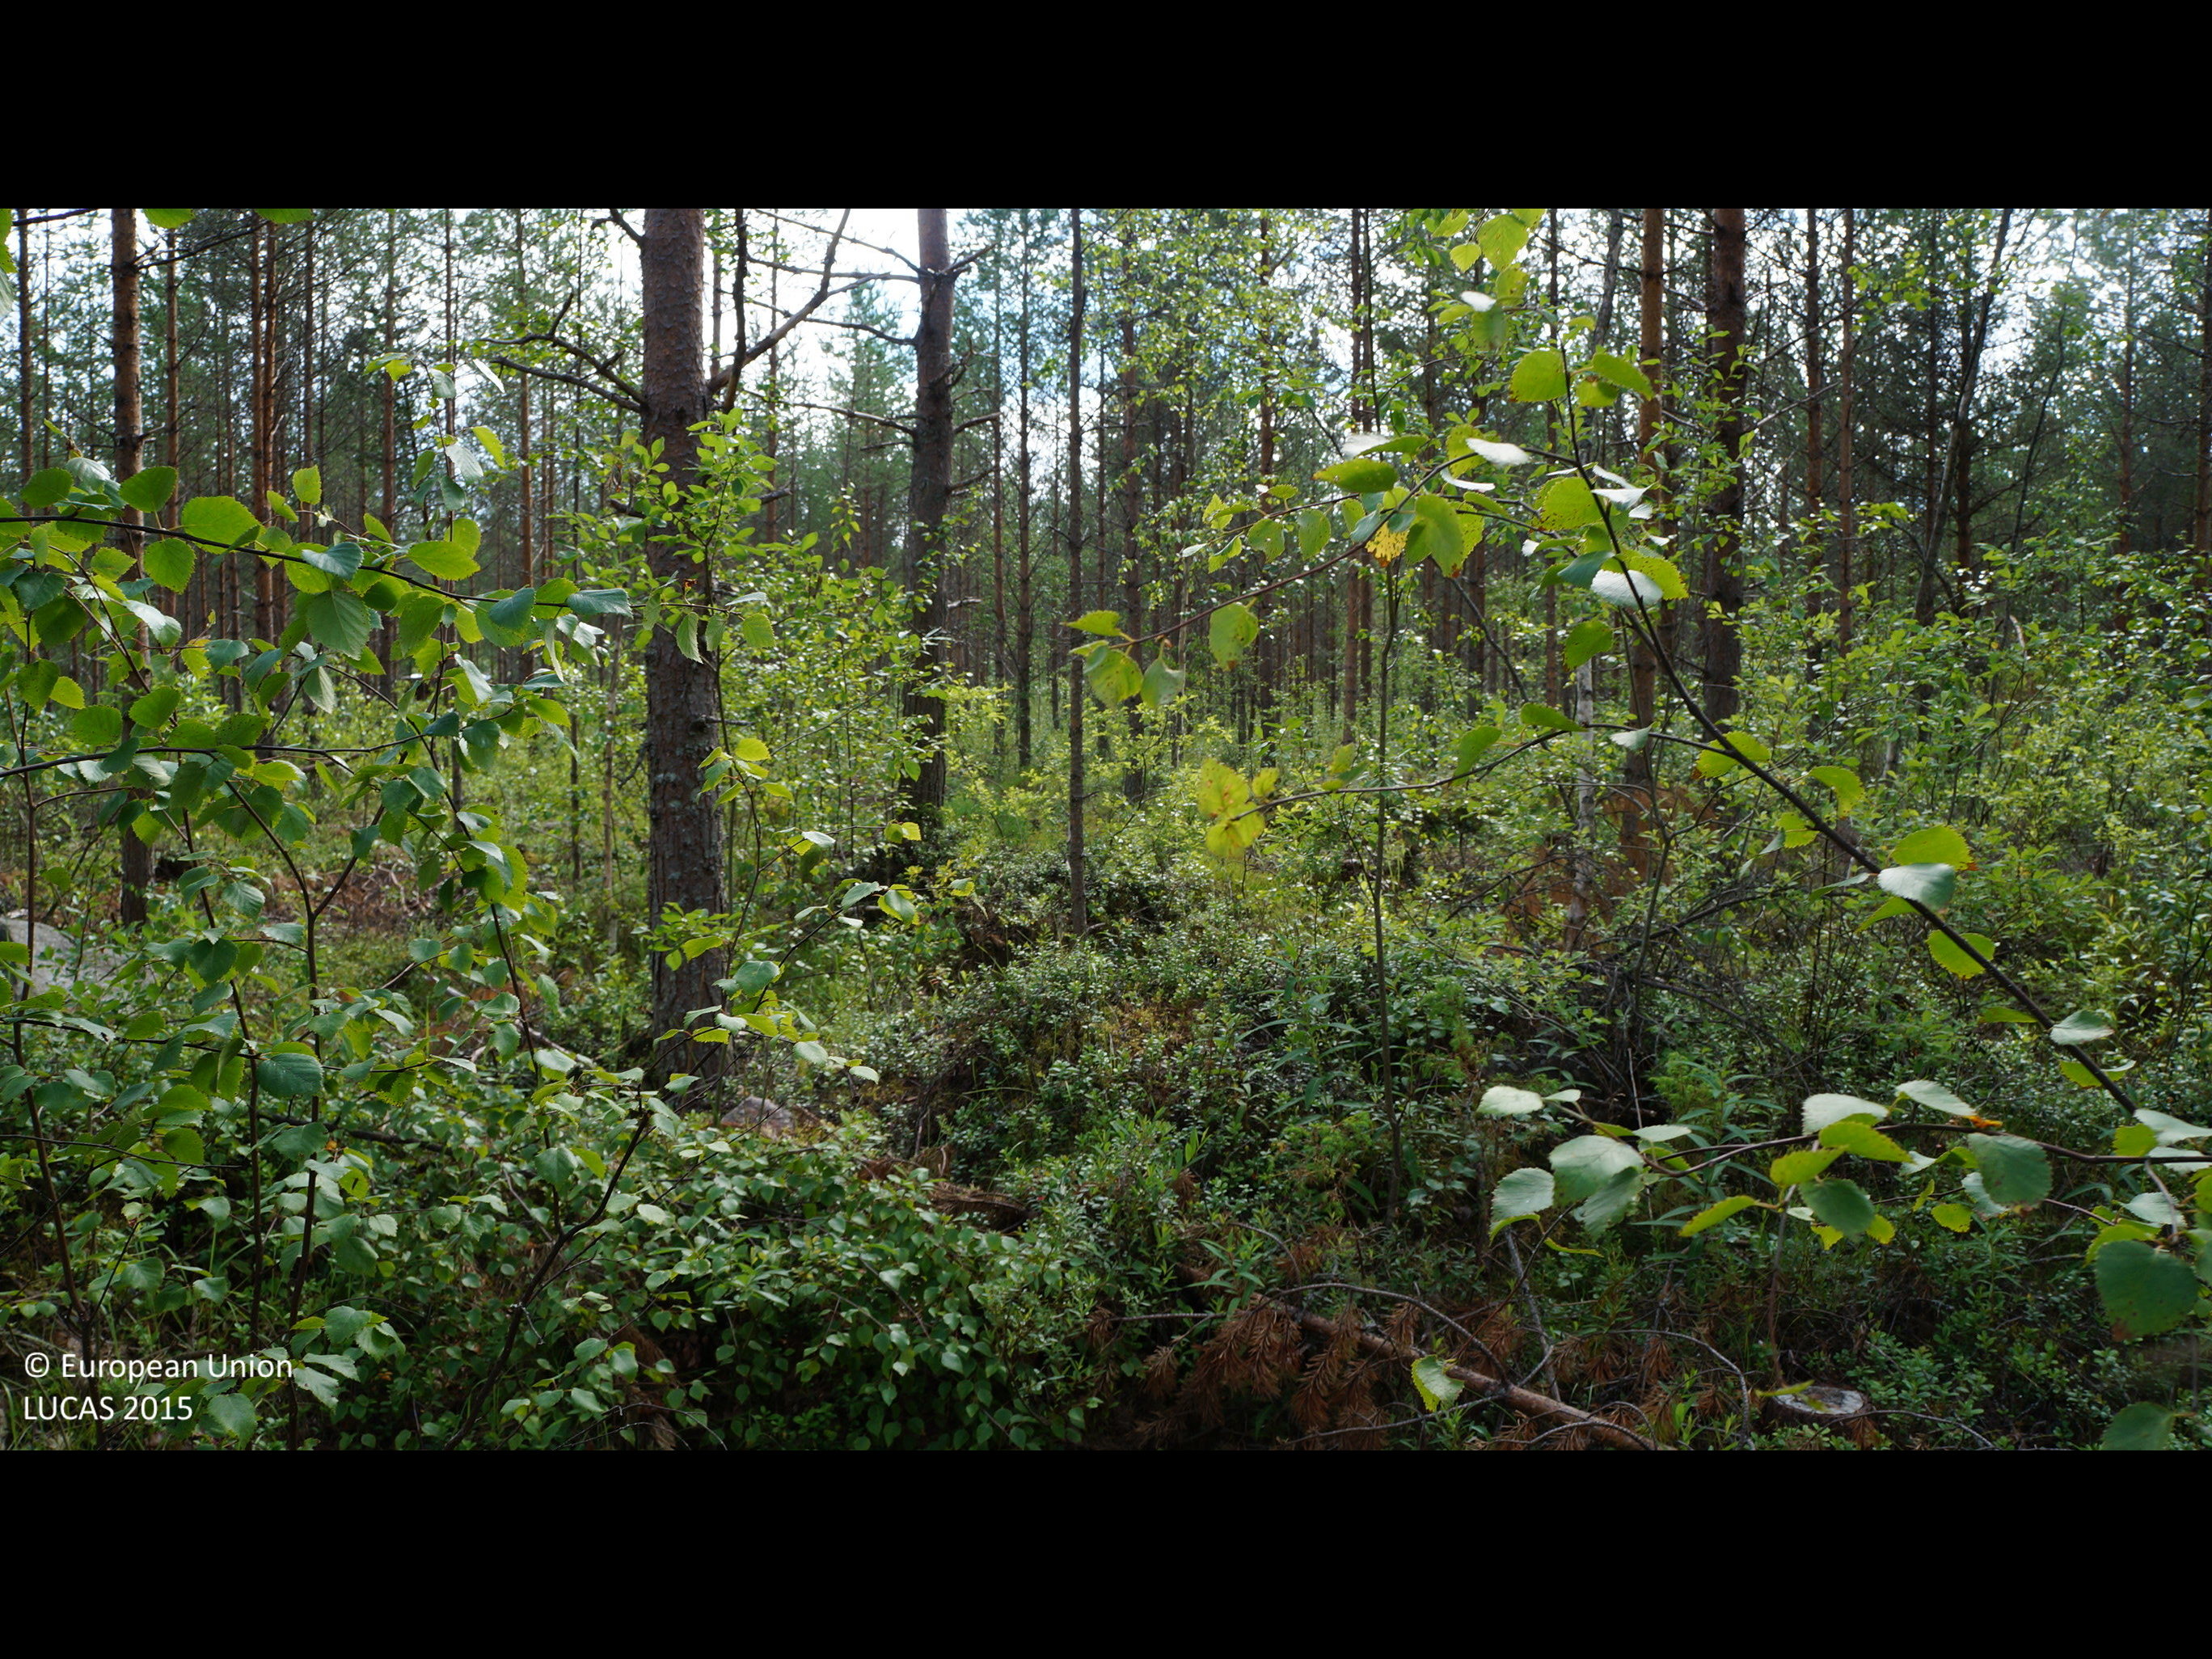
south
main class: Woodland
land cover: Pine dominated coniferous woodland
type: boreal forest
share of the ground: 25 - 50 %
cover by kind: shrubs 50 %, coniferous forest trees 40 %, herbaceous plants 5 %, lichens and mosses 5 %
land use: Forestry
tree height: > 5 m
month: July
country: FI
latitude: 64.0296
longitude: 24.4205
